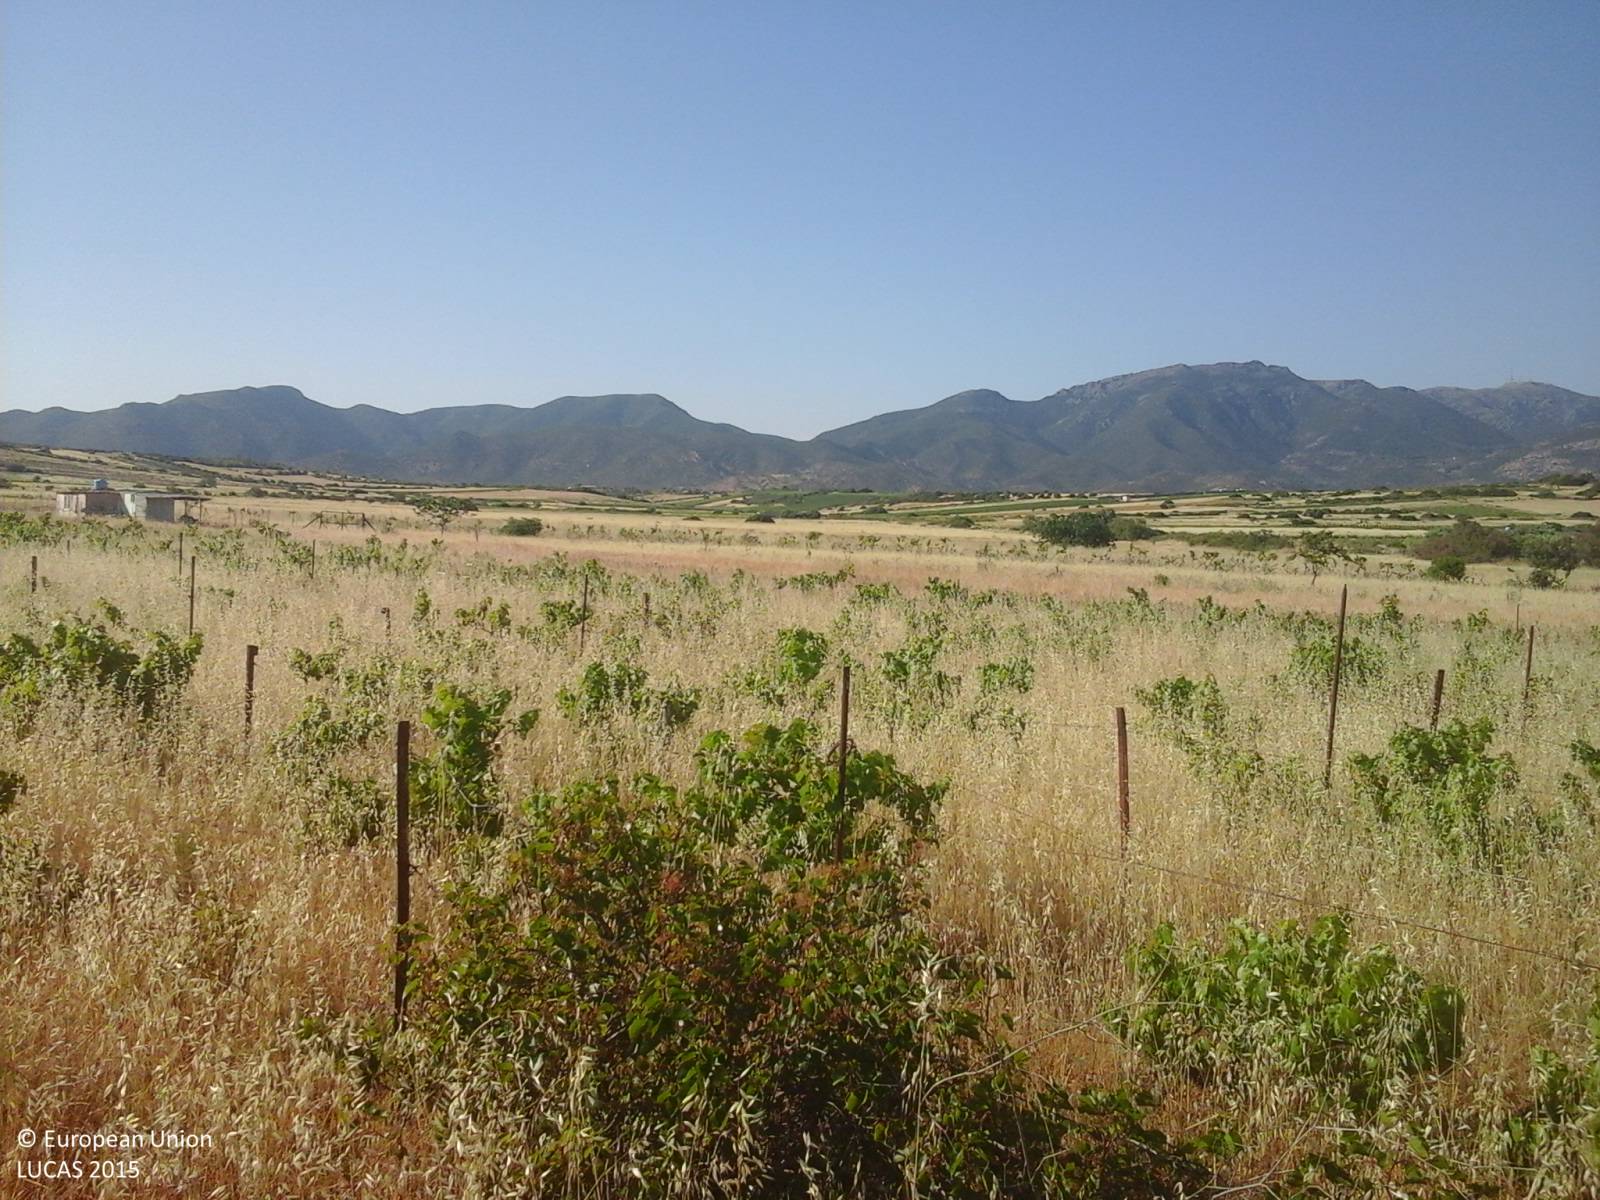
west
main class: Cropland
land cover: Vineyards
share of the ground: 50 - 75 %
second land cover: Oats
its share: 50 - 75 %
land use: Agriculture (excluding fallow land and kitchen gardens)
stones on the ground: 25 - 50 %
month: June
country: IT
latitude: 39.2864
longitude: 9.2510
